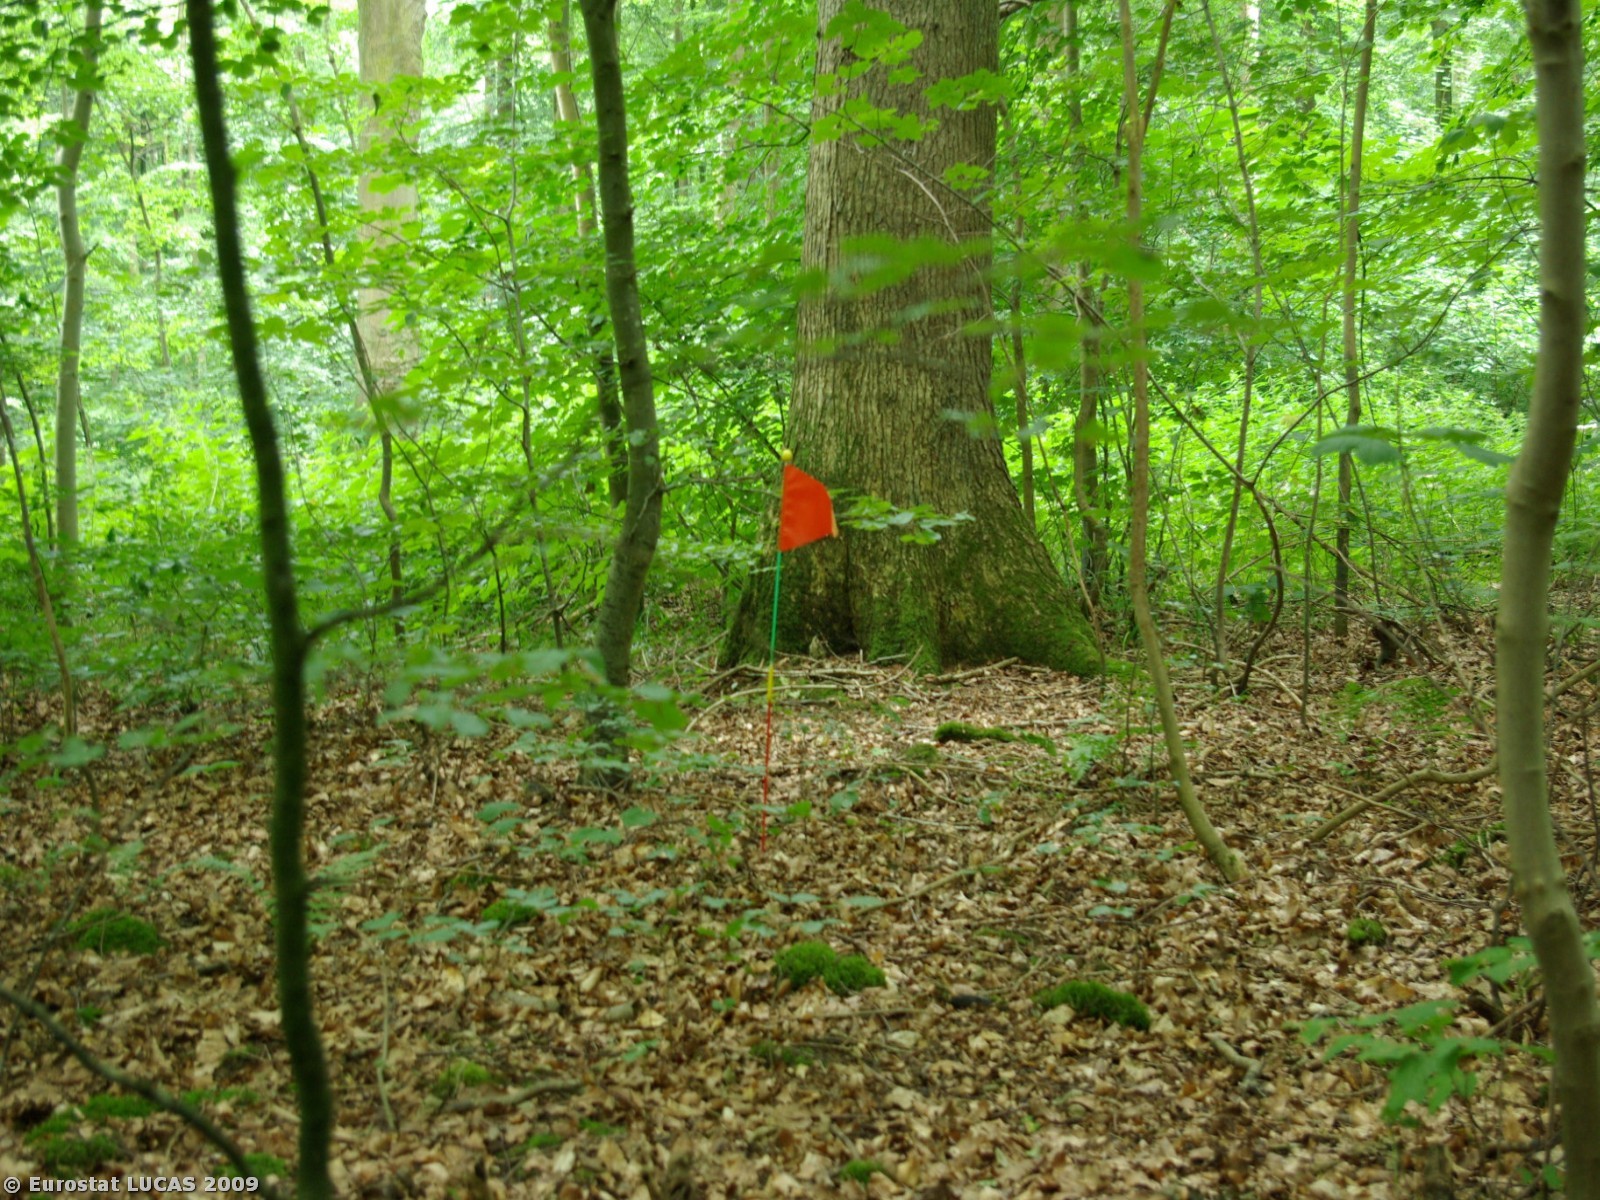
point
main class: Woodland
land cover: Broadleaved woodland
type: mesophytic deciduous forest
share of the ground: > 75 %
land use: Forestry
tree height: > 5 m
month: July
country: DK
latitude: 55.0194
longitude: 9.8906
